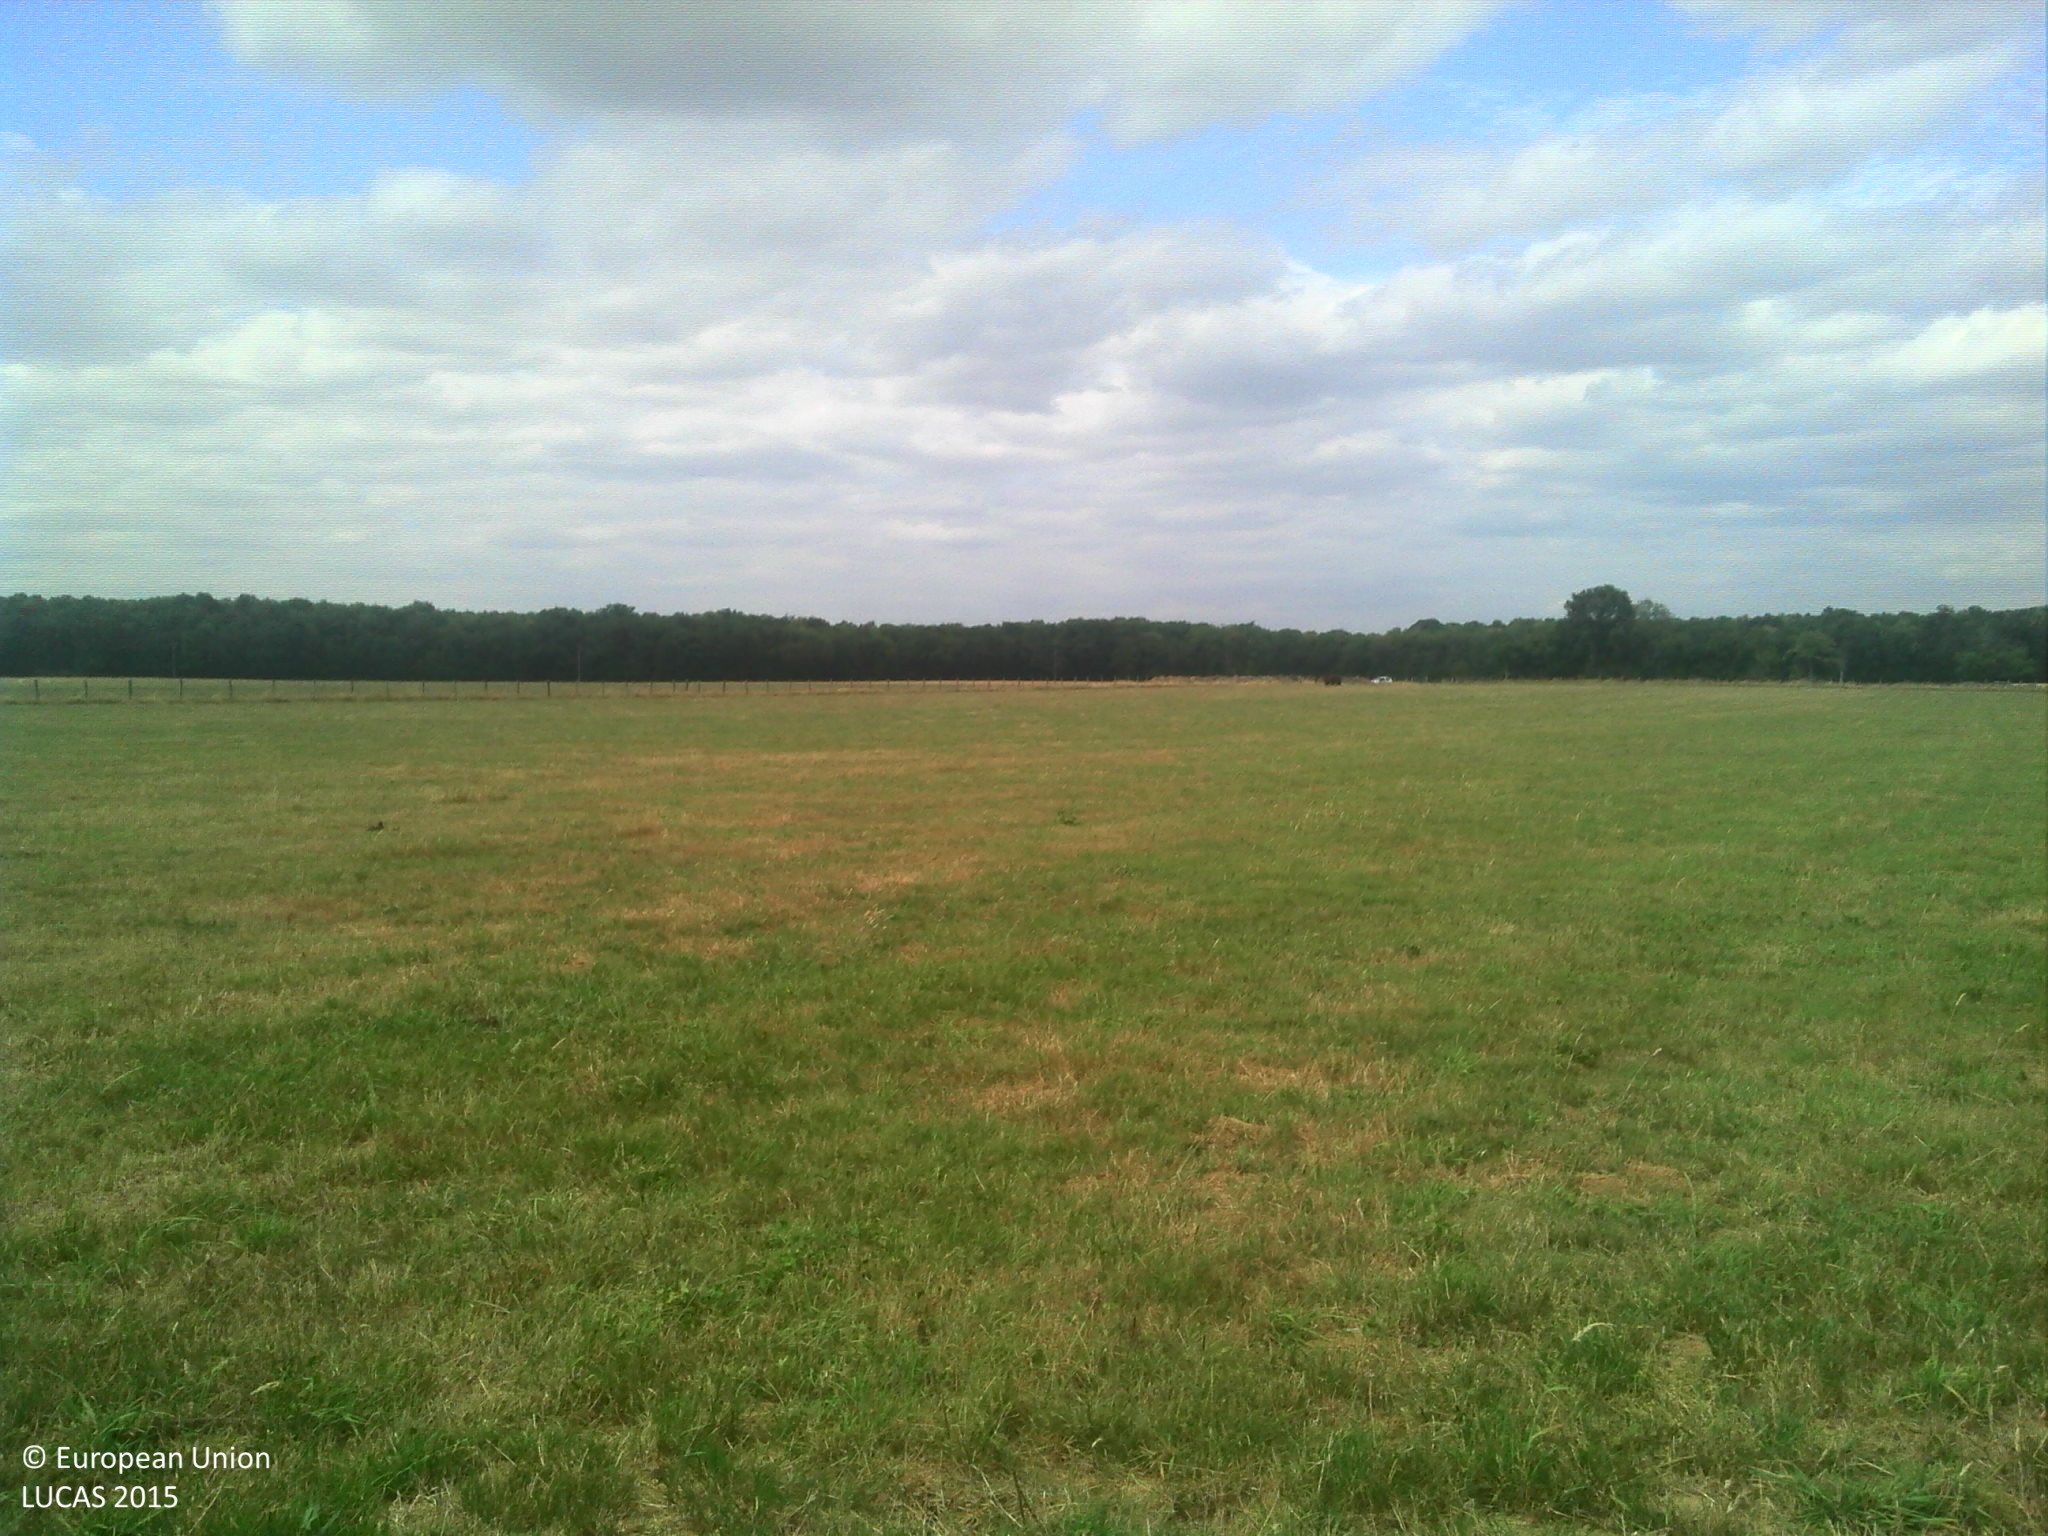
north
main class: Grassland
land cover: Grassland without tree/shrub cover
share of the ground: > 75 %
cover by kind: herbaceous plants 100 %
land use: Agriculture (excluding fallow land and kitchen gardens)
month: July
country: FR
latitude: 48.0965
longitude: 5.0981
